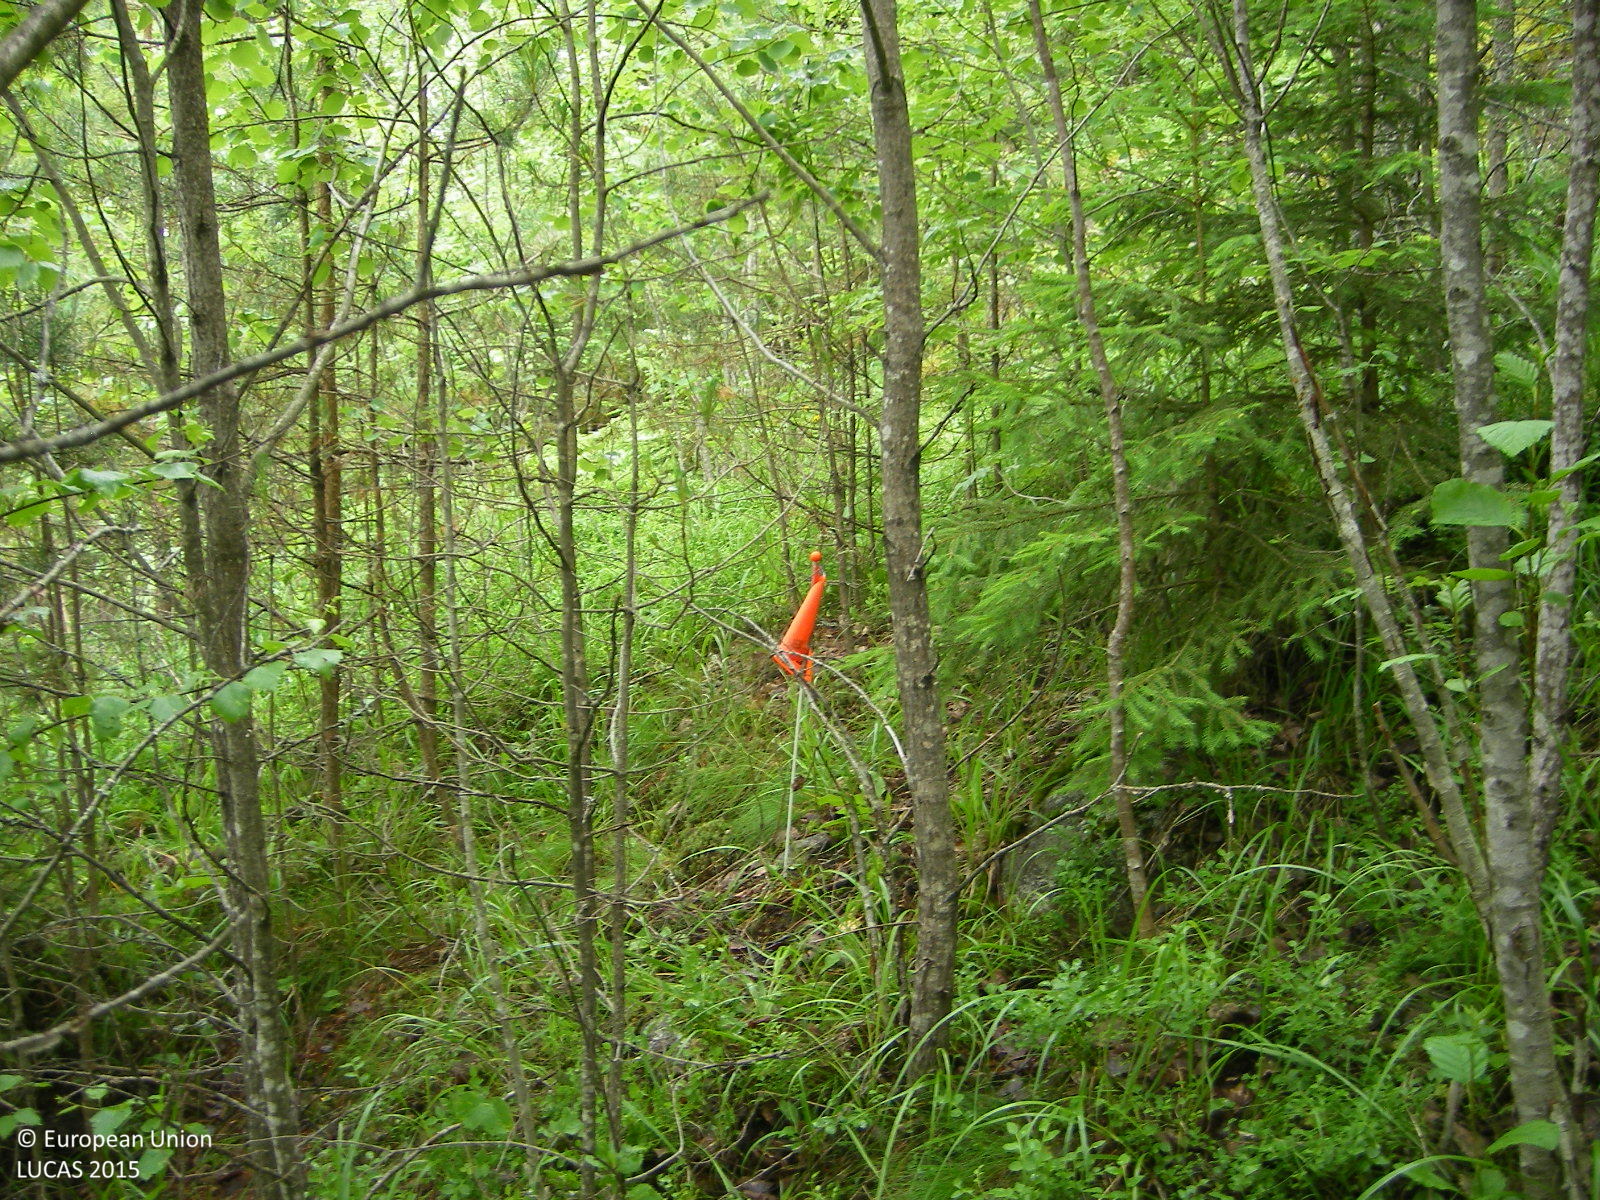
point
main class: Woodland
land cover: Broadleaved woodland
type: boreal forest
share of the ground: > 75 %
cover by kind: broadleaved forest trees 90 %, coniferous forest trees 5 %, shrubs 5 %
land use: Forestry
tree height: > 5 m
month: June
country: FI
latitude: 60.3559
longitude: 23.2604
